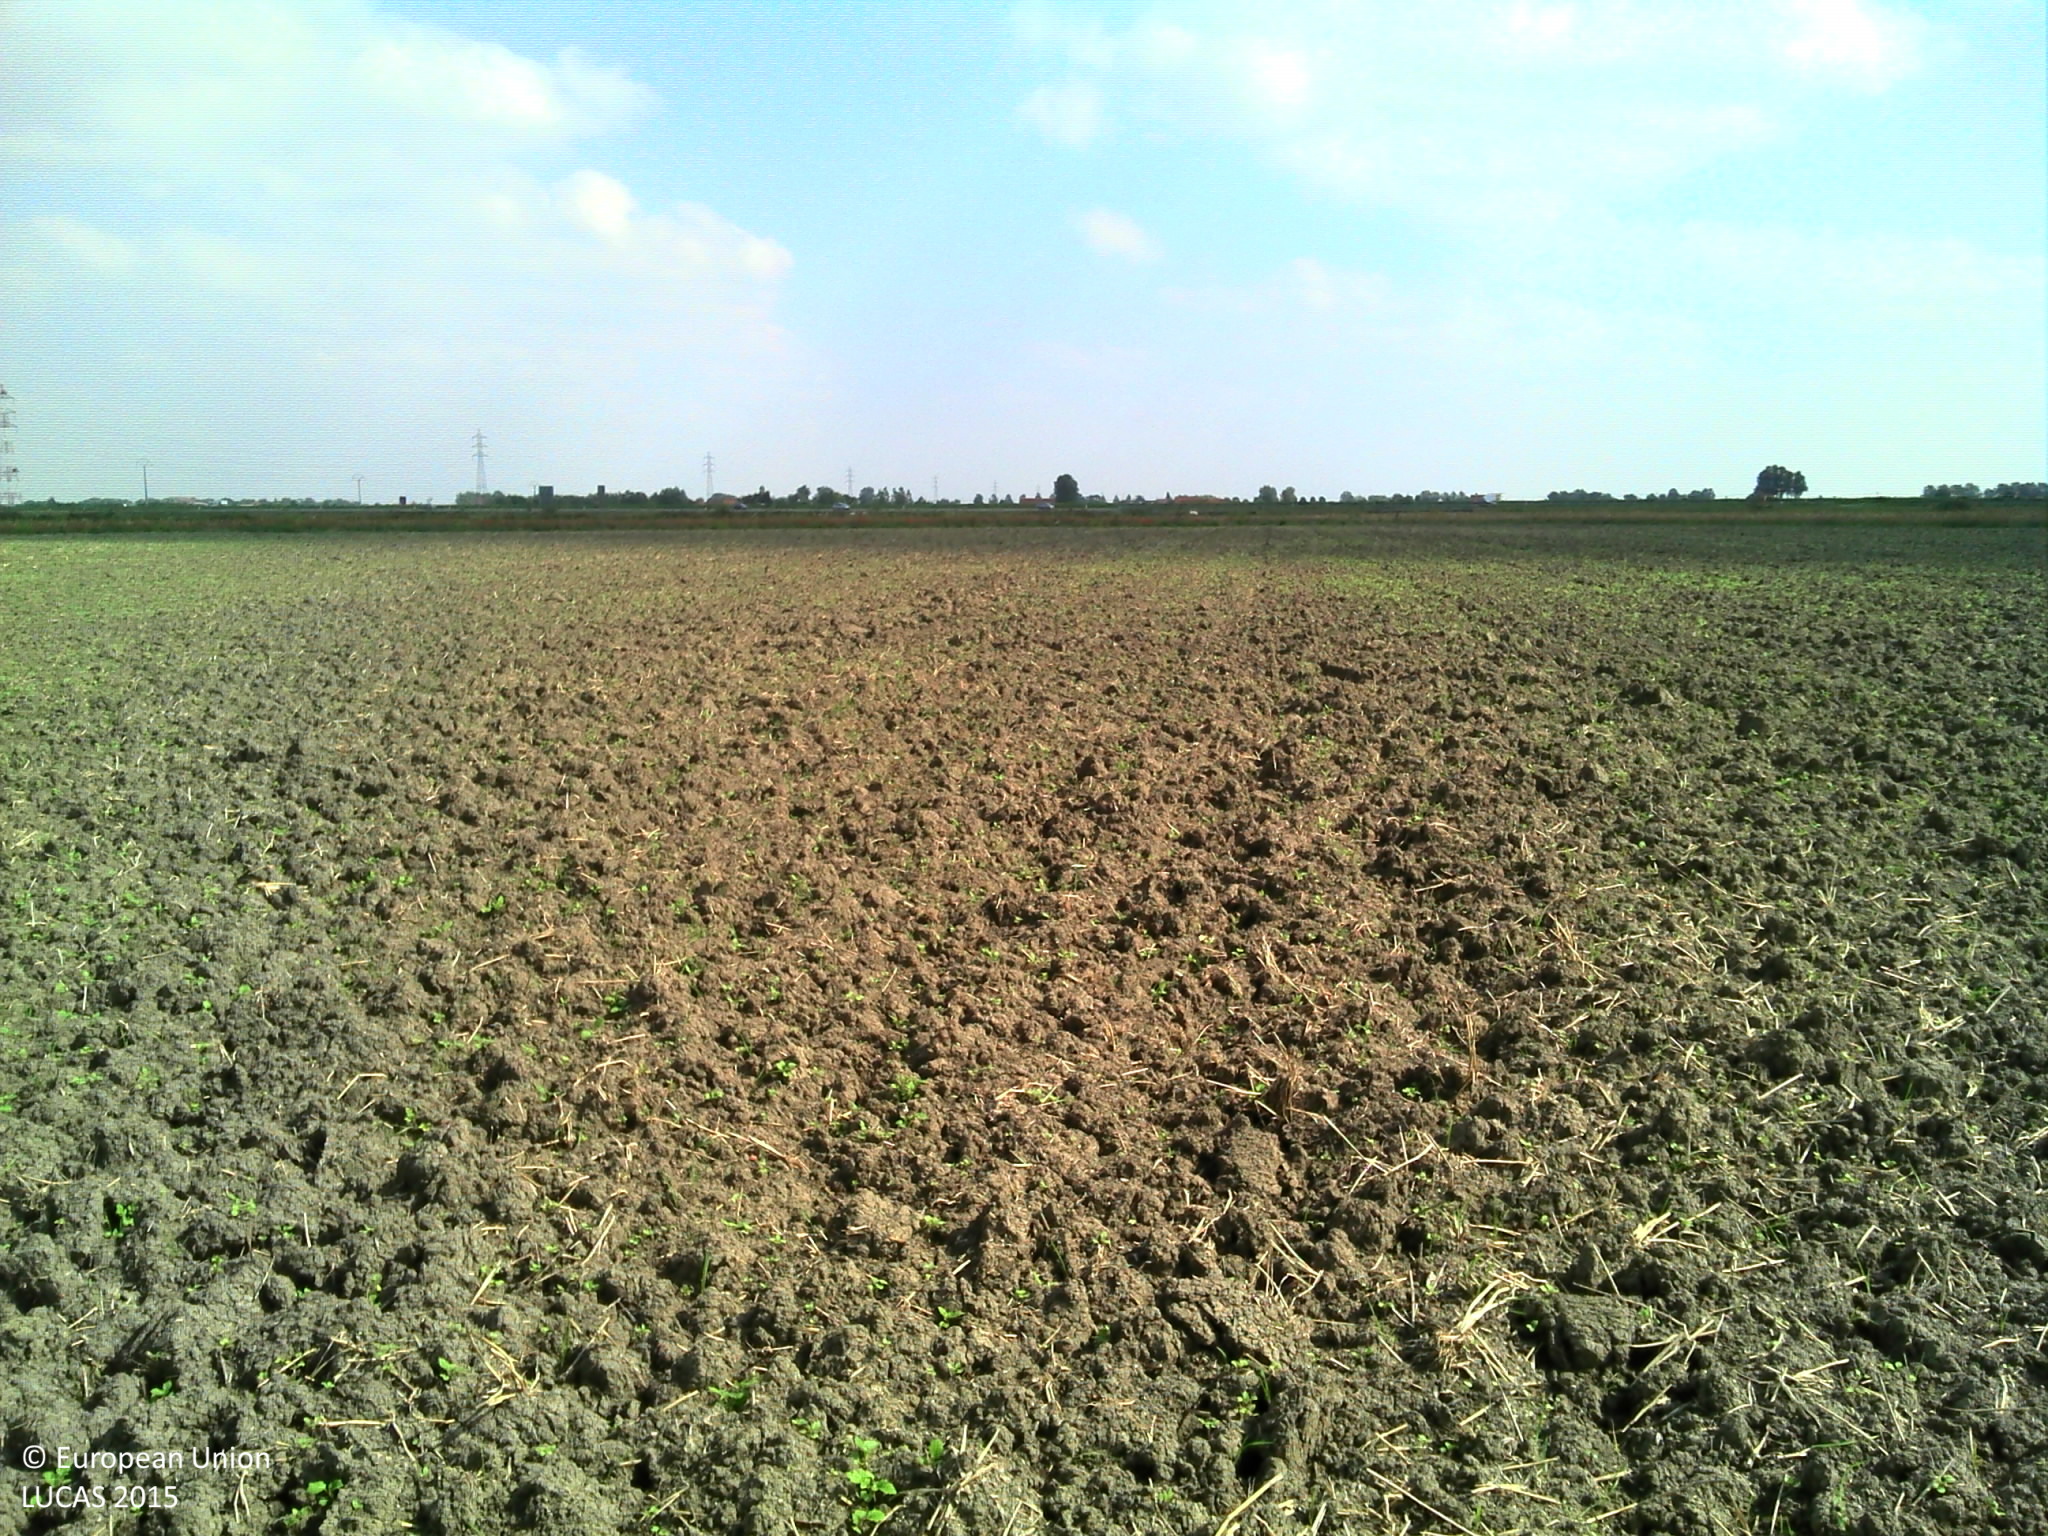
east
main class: Cropland
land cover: Common wheat
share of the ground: < 10 %
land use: Agriculture (excluding fallow land and kitchen gardens)
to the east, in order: Common wheat; Grassland without tree/shrub cover; Inland fresh running water; Grass margins; Fences; Grassland without tree/shrub cover
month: September
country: BE
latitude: 51.0889
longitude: 2.7214
